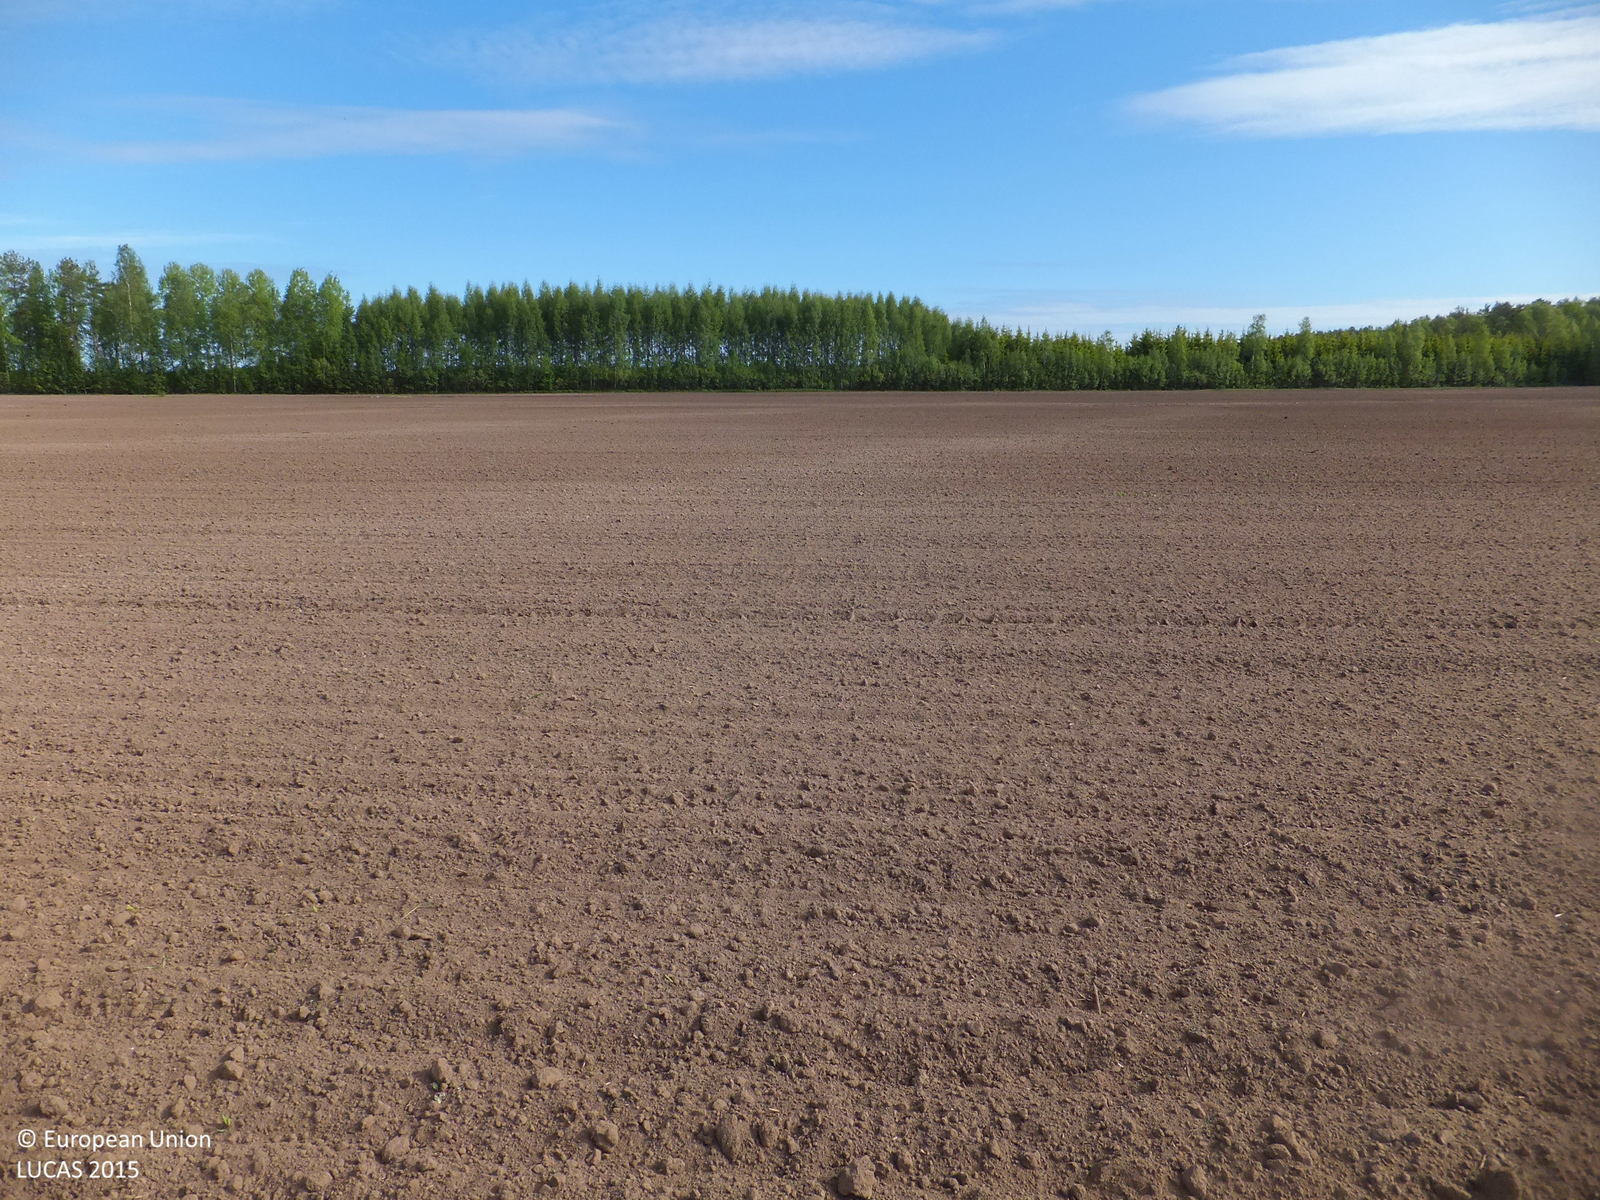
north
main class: Cropland
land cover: Barley
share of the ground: < 10 %
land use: Agriculture (excluding fallow land and kitchen gardens)
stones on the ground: < 10 %
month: June
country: FI
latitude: 63.3892
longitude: 22.7177
